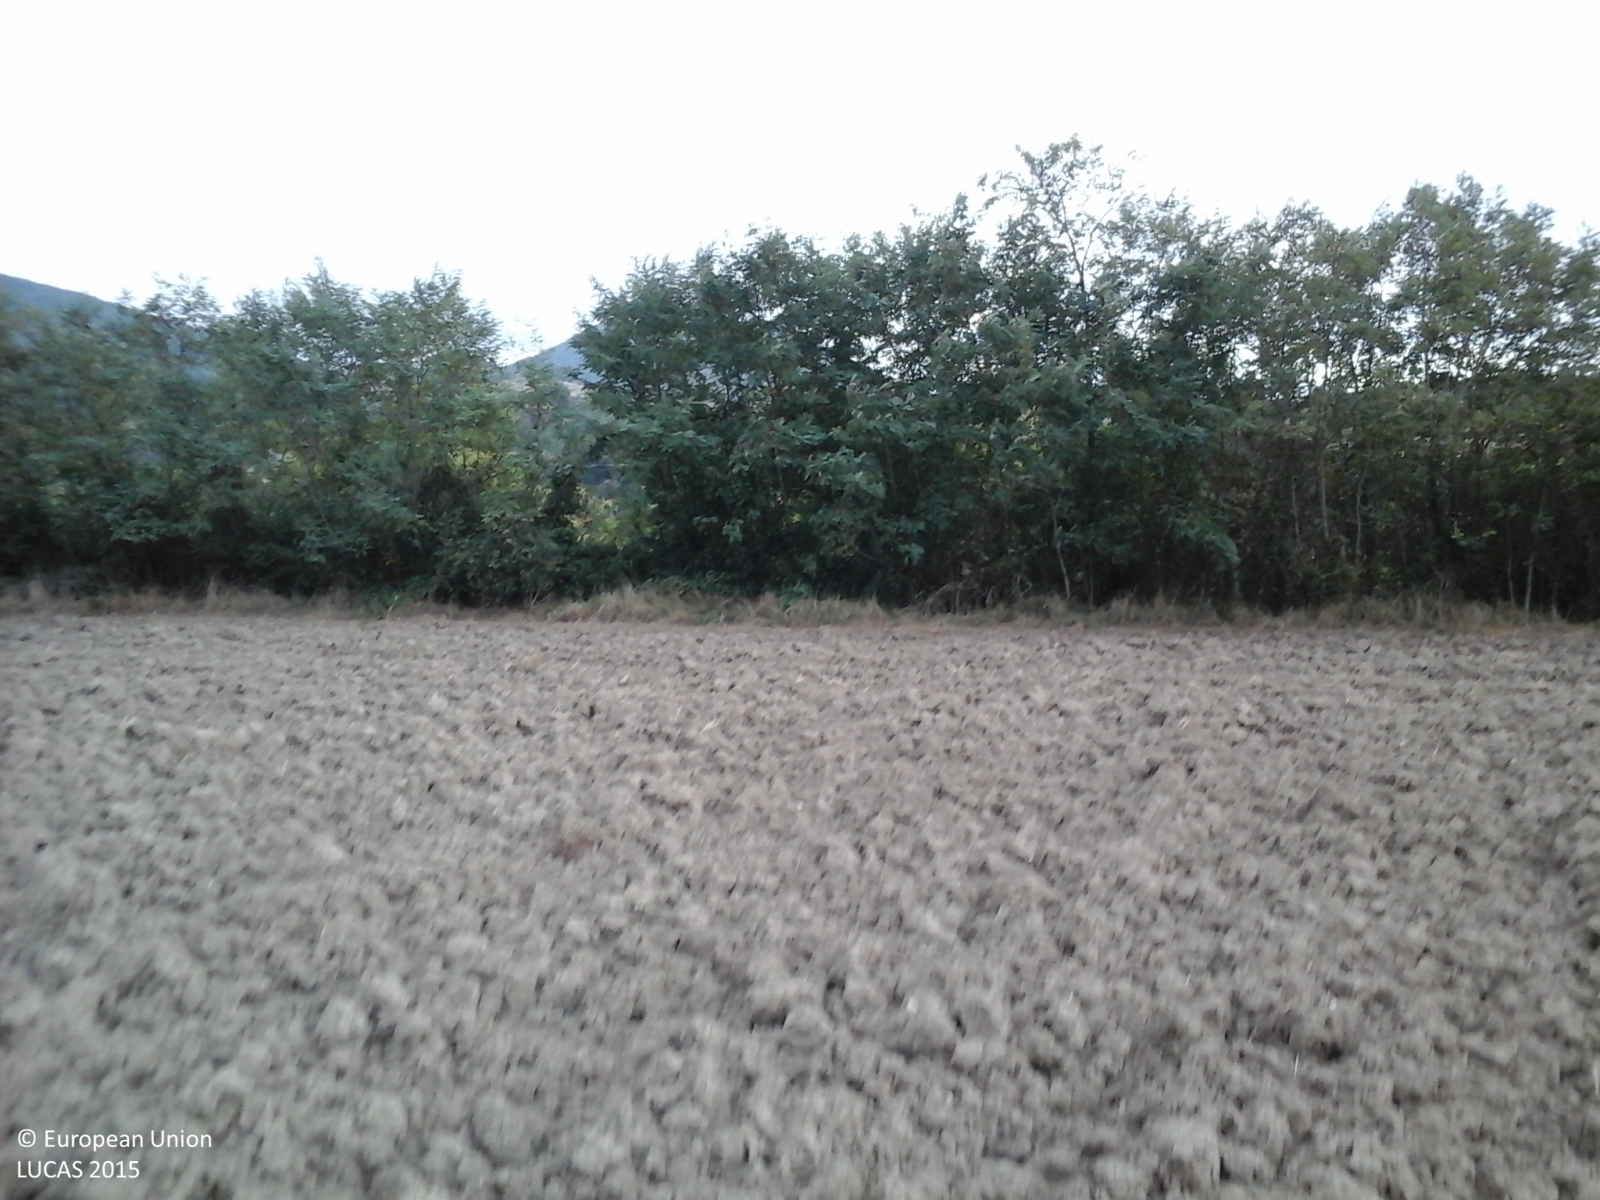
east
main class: Cropland
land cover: Durum wheat
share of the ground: < 10 %
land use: Agriculture (excluding fallow land and kitchen gardens)
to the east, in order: Durum wheat; Broadleaved woodland; Railways; Grass margins; Abandoned hedges; Grass margins; Paved roads, cycling and walking lanes; Grass margins; Other bare soil; Grass margins; Single bushes/trees; Vineyards; Spontaneously vegetated surfaces
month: September
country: IT
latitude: 43.3909
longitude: 12.8443
